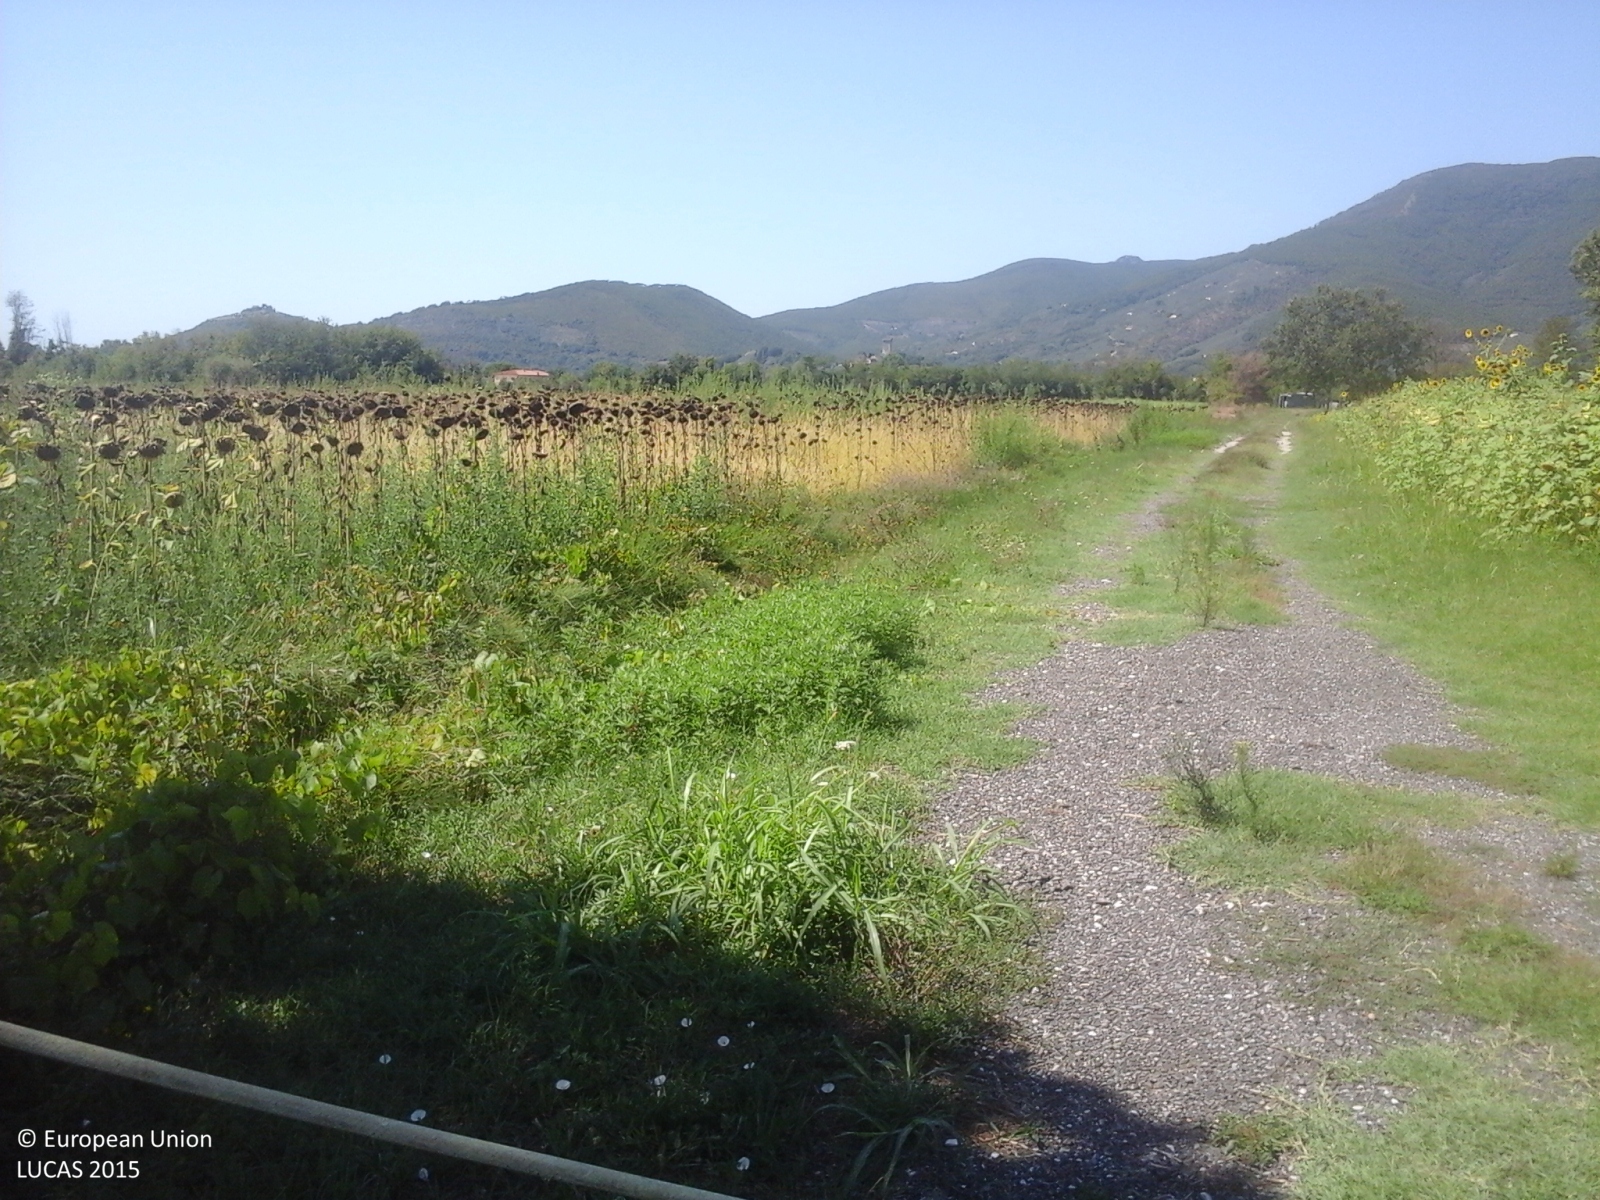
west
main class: Cropland
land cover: Sunflower
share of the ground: > 75 %
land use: Agriculture (excluding fallow land and kitchen gardens)
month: August
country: IT
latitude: 43.6993
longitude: 10.6064
